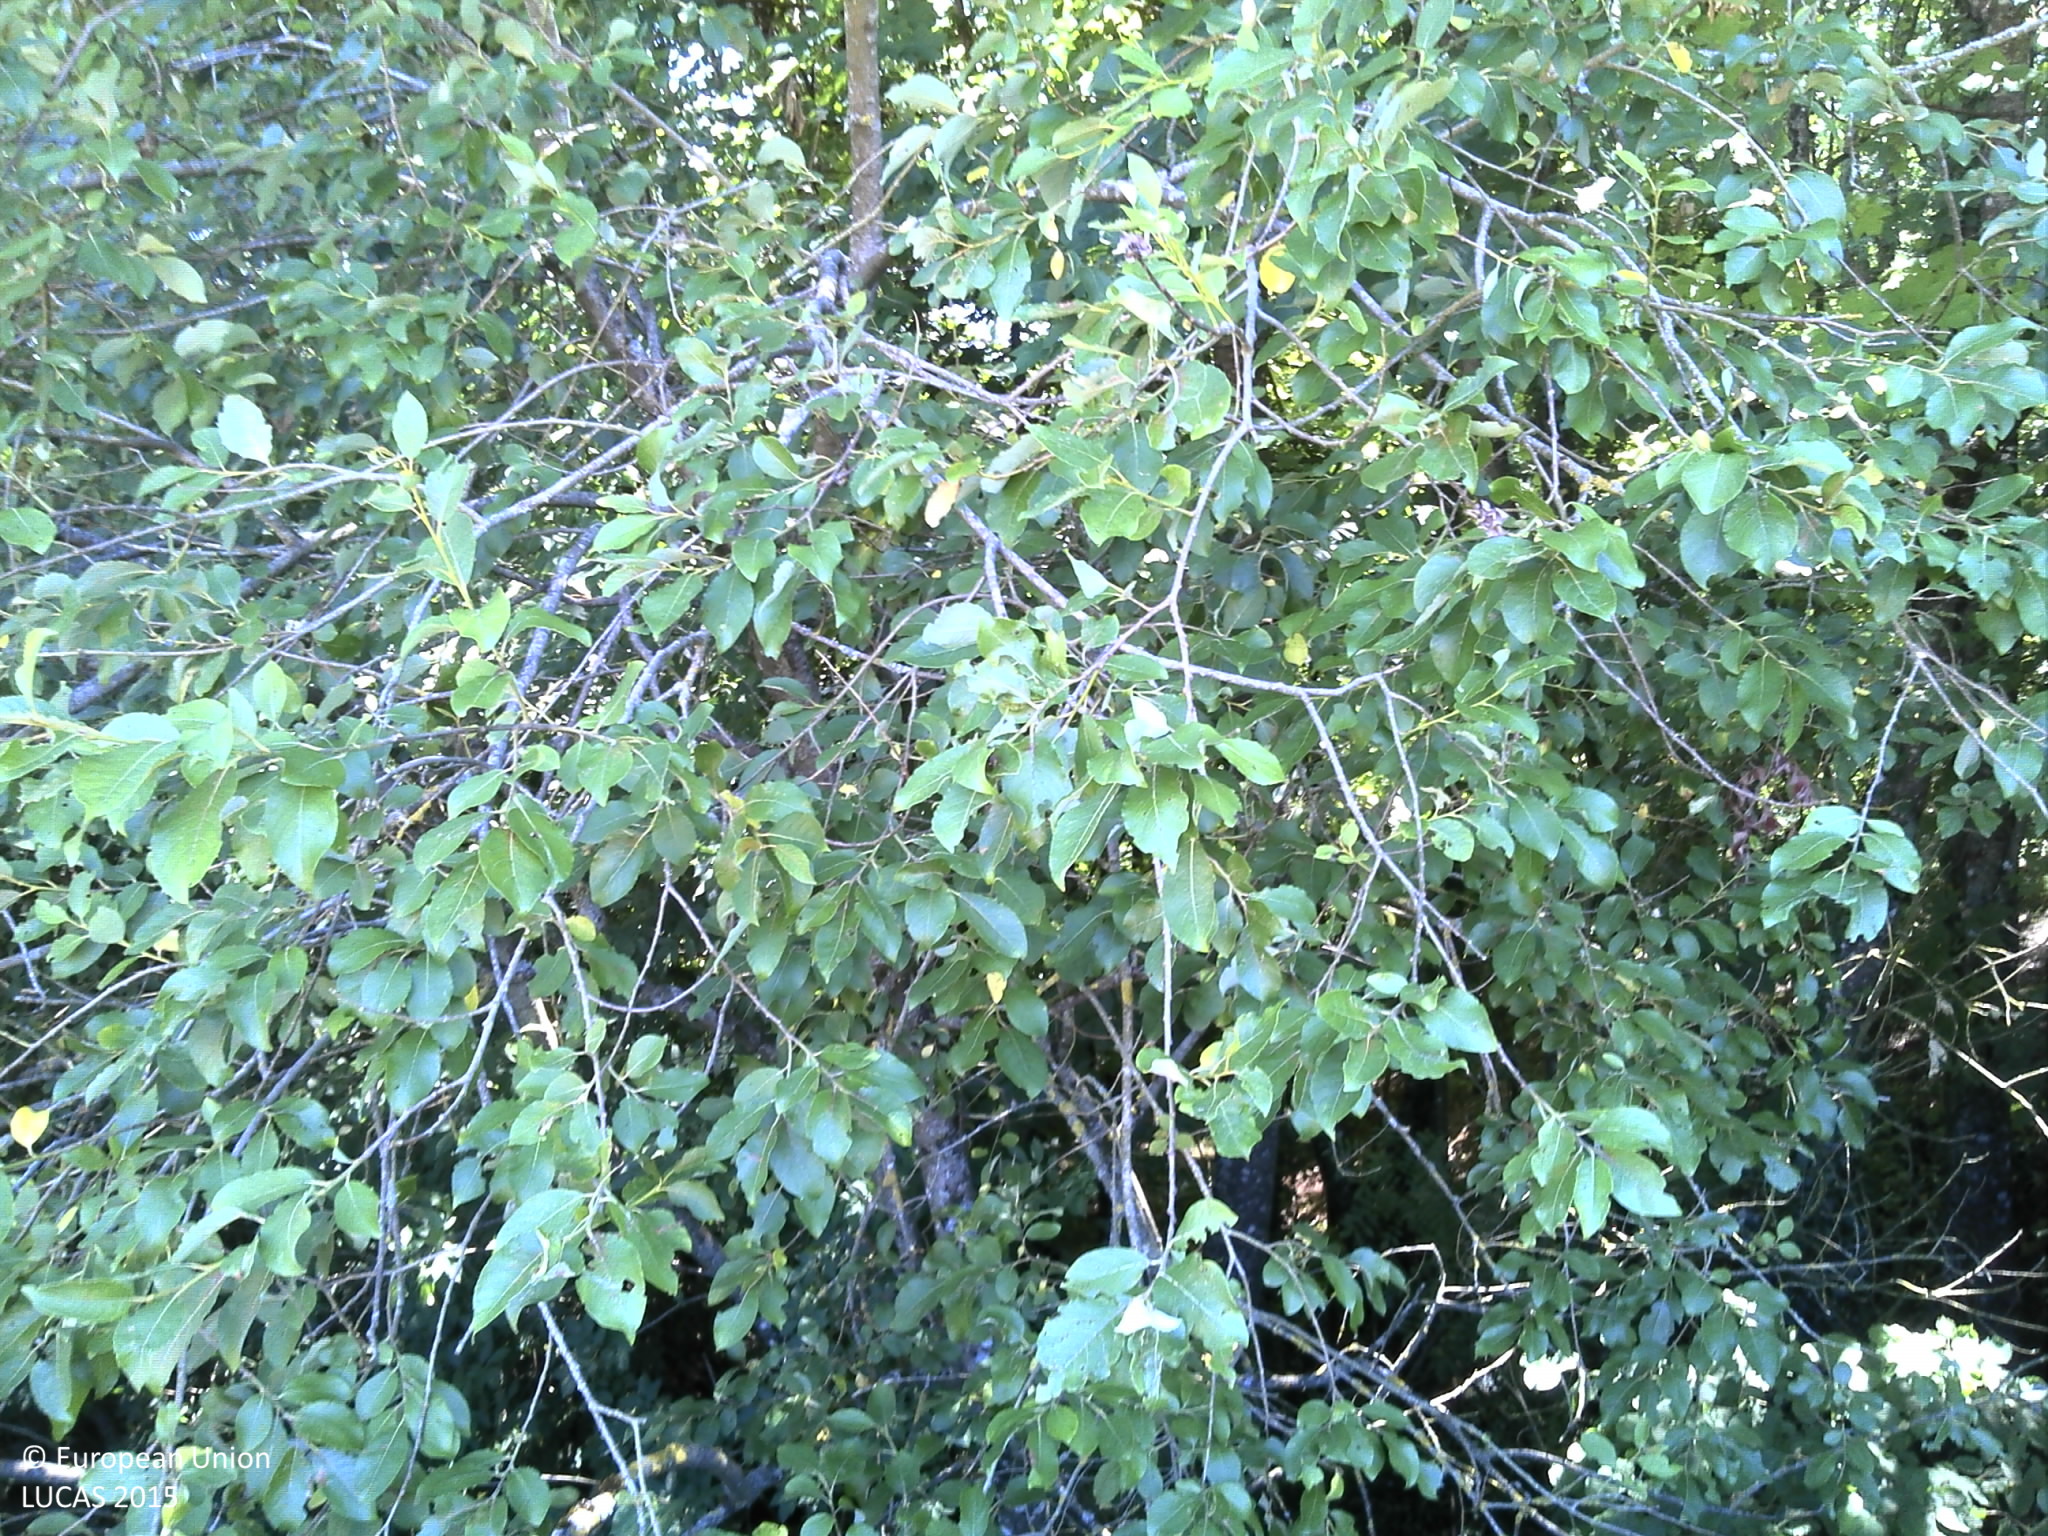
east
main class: Grassland
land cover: Grassland without tree/shrub cover
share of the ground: > 75 %
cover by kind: herbaceous plants 100 %
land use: Agriculture (excluding fallow land and kitchen gardens)
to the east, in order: Grassland without tree/shrub cover; Broadleaved woodland; Fences; Grassland without tree/shrub cover; Fences; Broadleaved woodland; Barley; Managed hedges; Fences; Grassland without tree/shrub cover; Broadleaved woodland; Grassland without tree/shrub cover
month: July
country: FR
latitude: 49.5718
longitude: 4.6451
